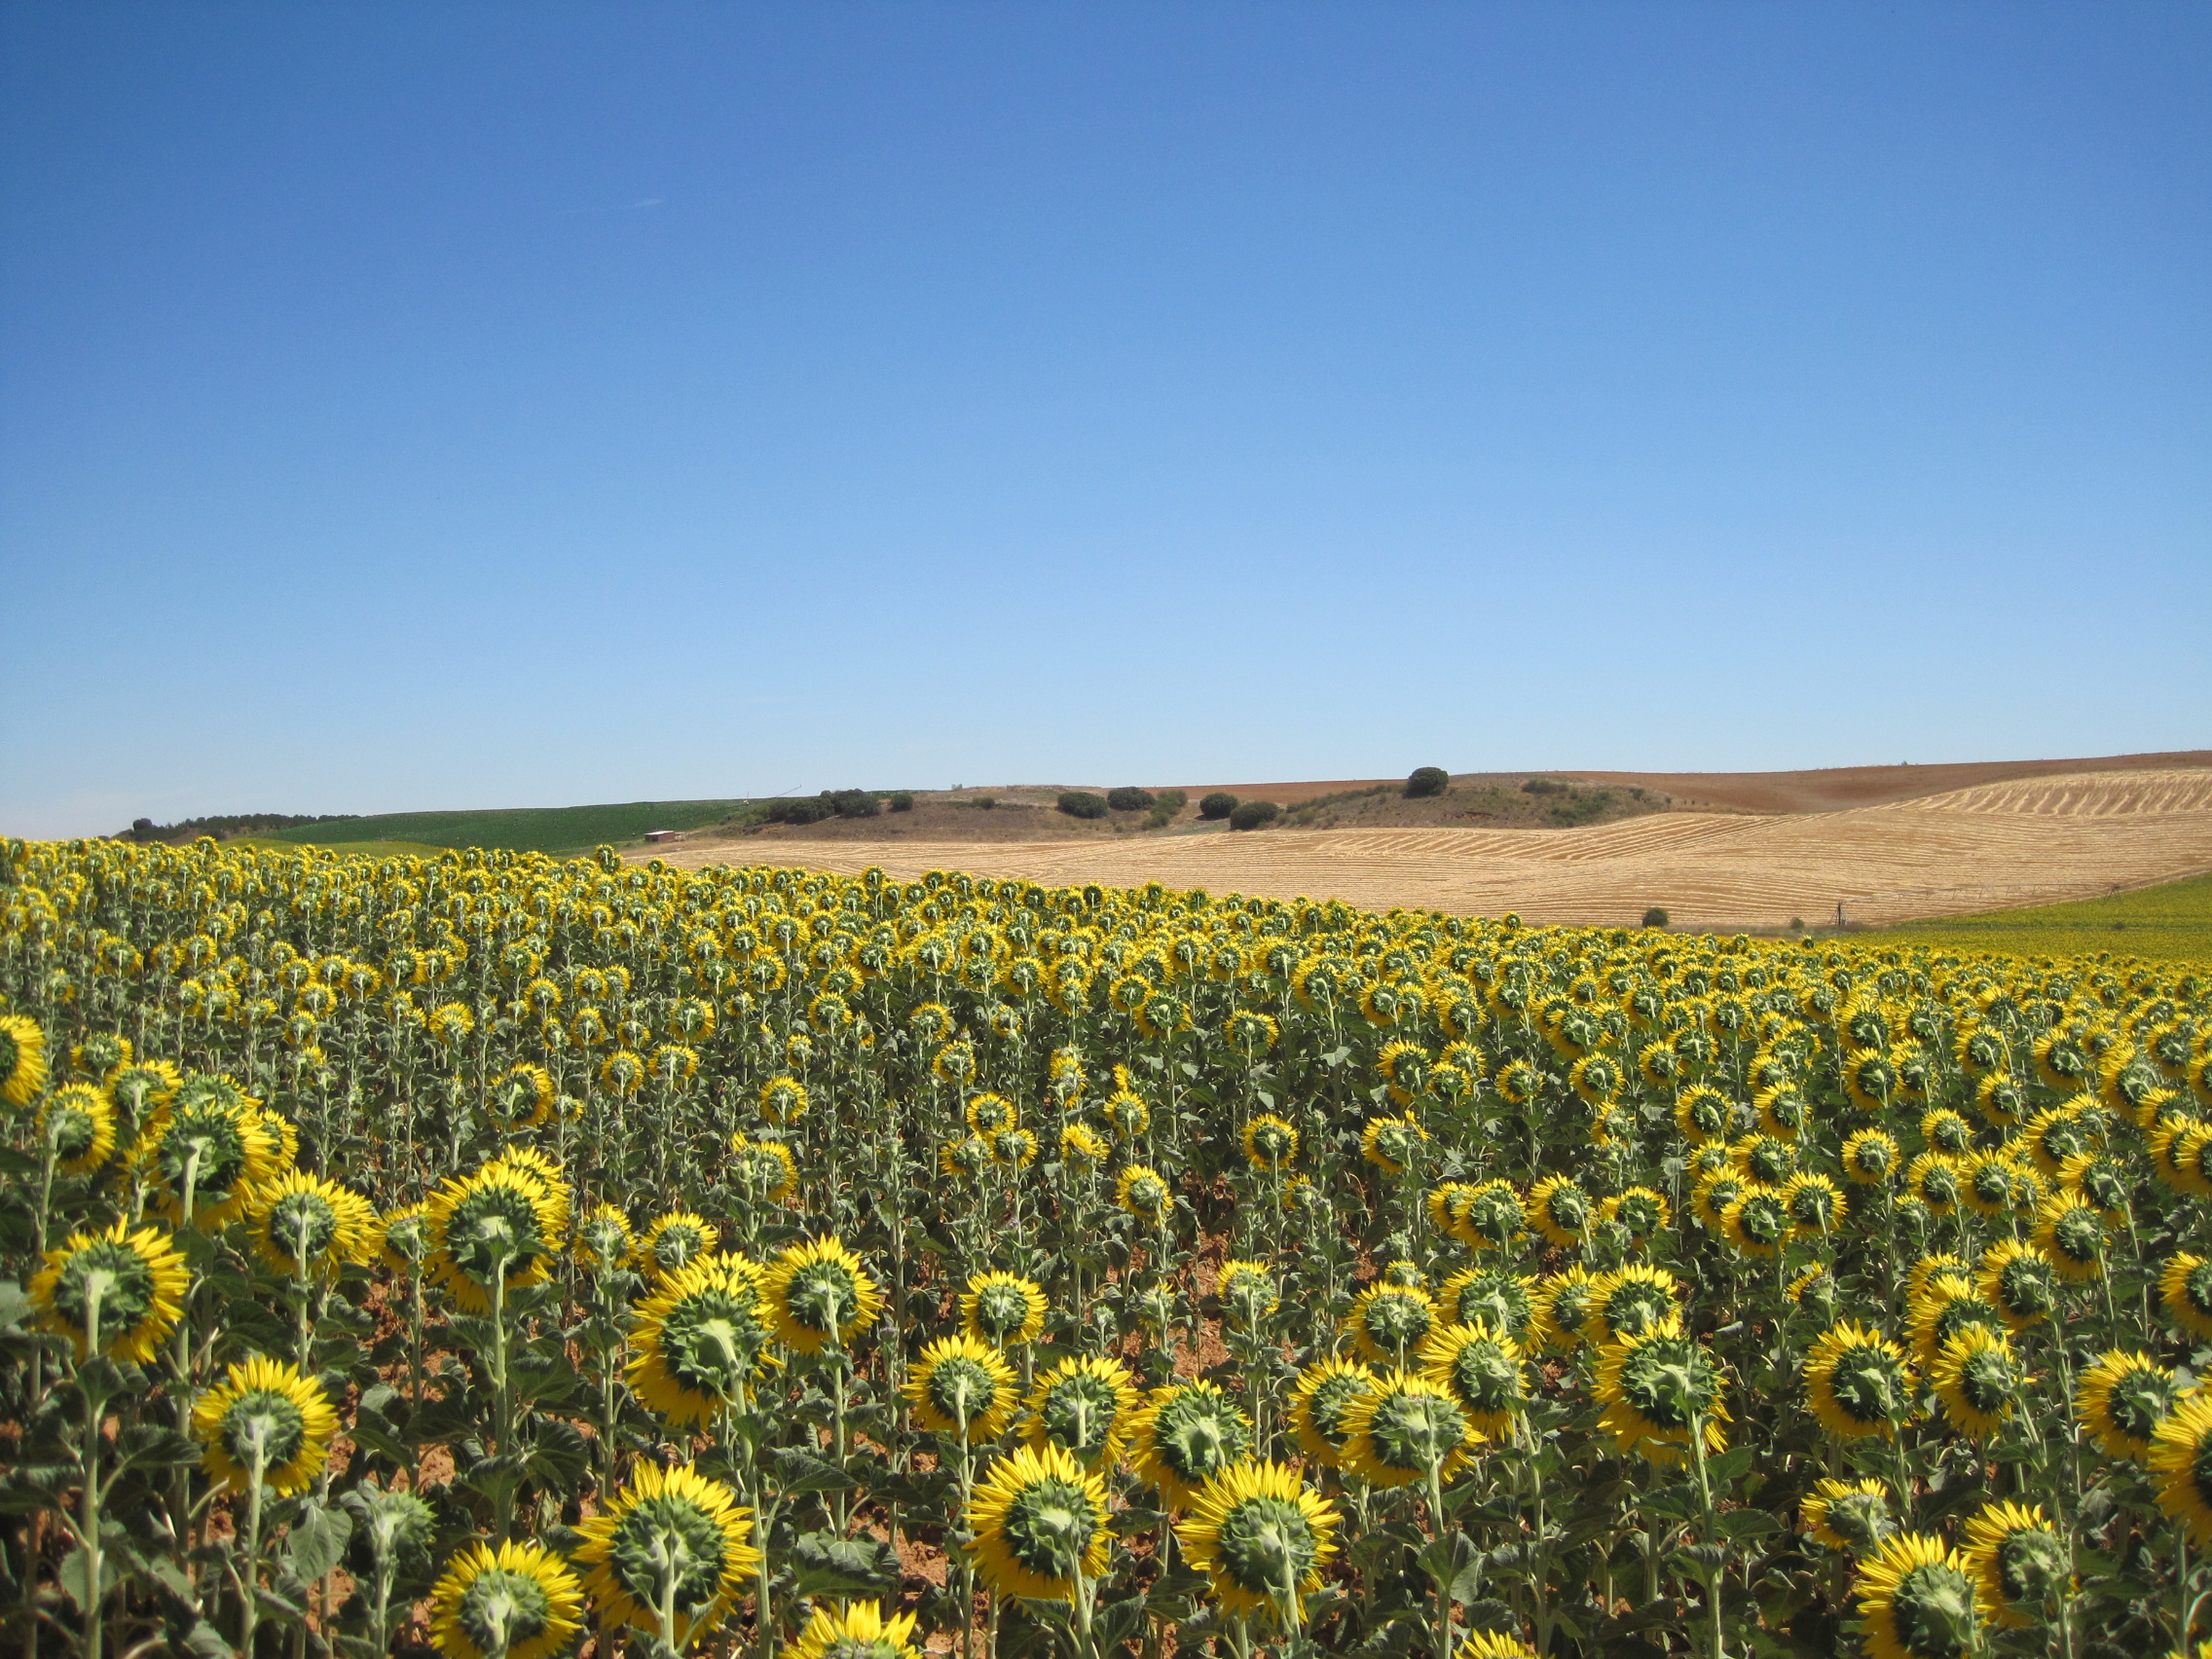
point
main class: Cropland
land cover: Sunflower
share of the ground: > 75 %
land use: Agriculture (excluding fallow land and kitchen gardens)
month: July
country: ES
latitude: 42.1544
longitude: -5.4713
